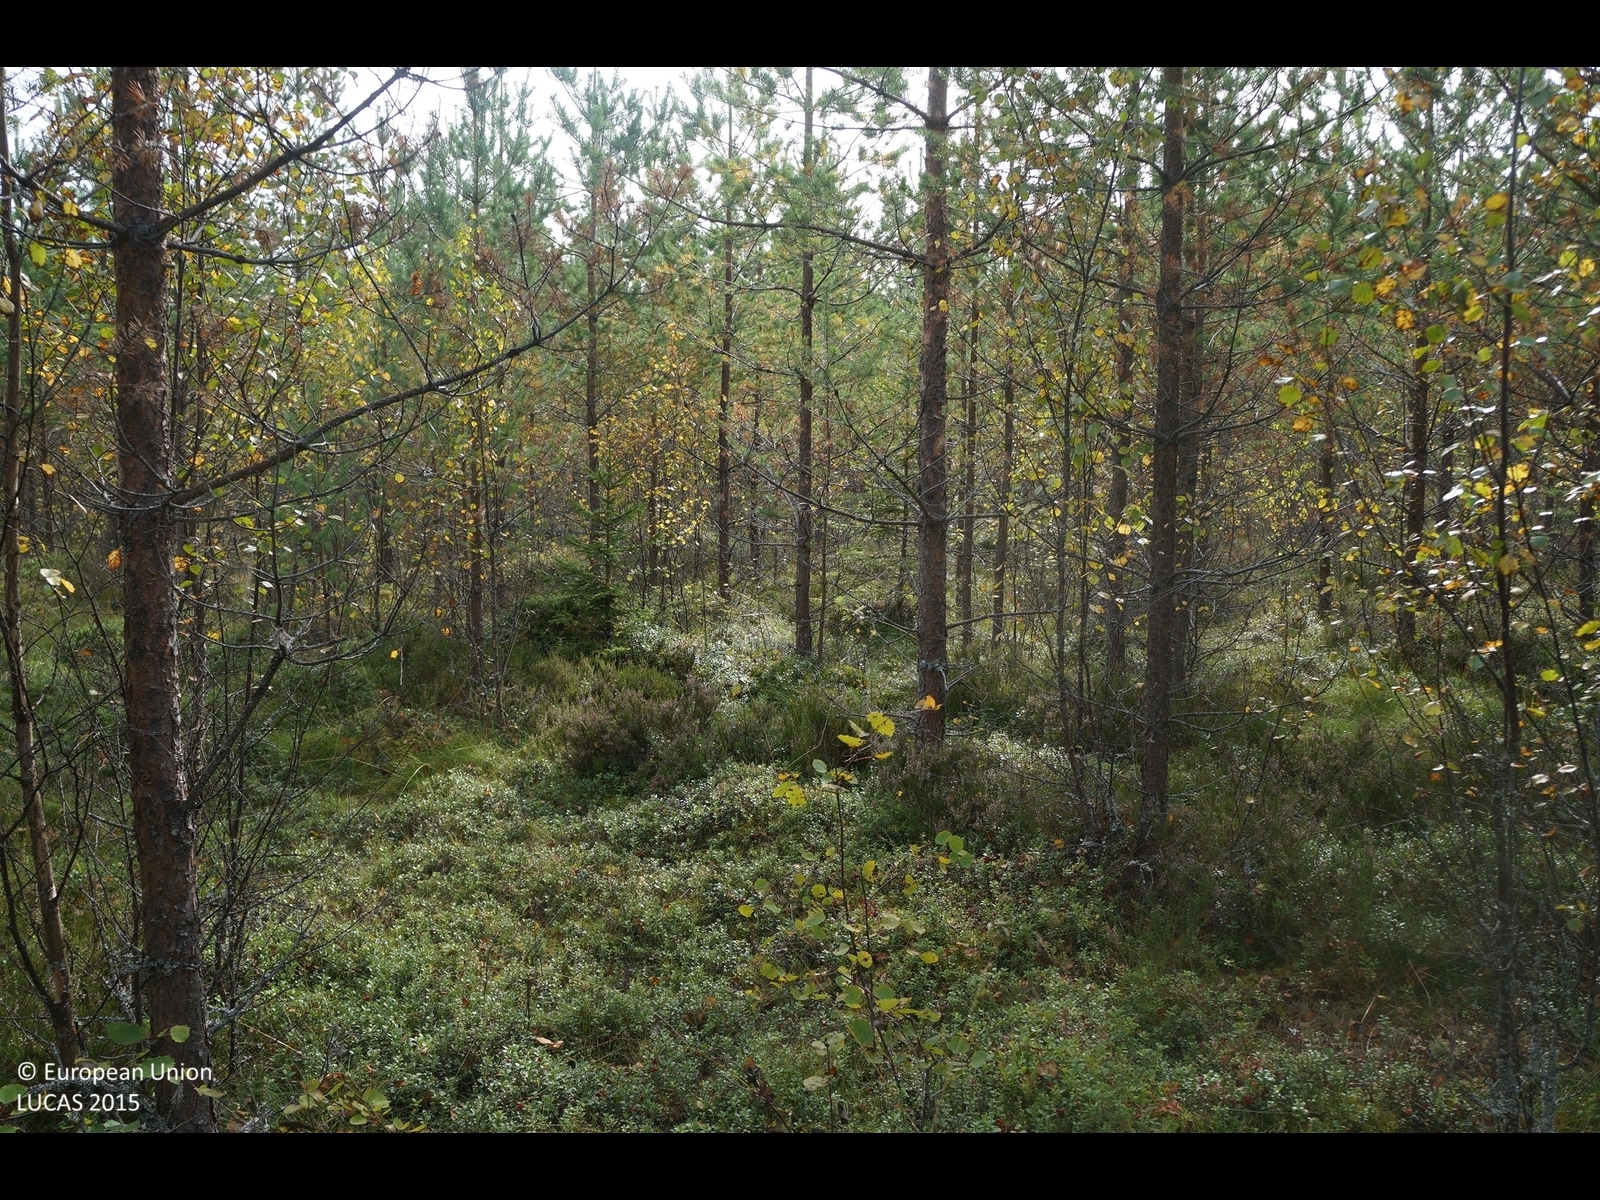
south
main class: Woodland
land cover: Pine dominated coniferous woodland
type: boreal forest
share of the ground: 50 - 75 %
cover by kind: coniferous forest trees 50 %, shrubs 35 %, lichens and mosses 10 %, herbaceous plants 5 %
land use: Forestry
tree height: > 5 m
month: September
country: FI
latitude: 64.0275
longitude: 23.8358
